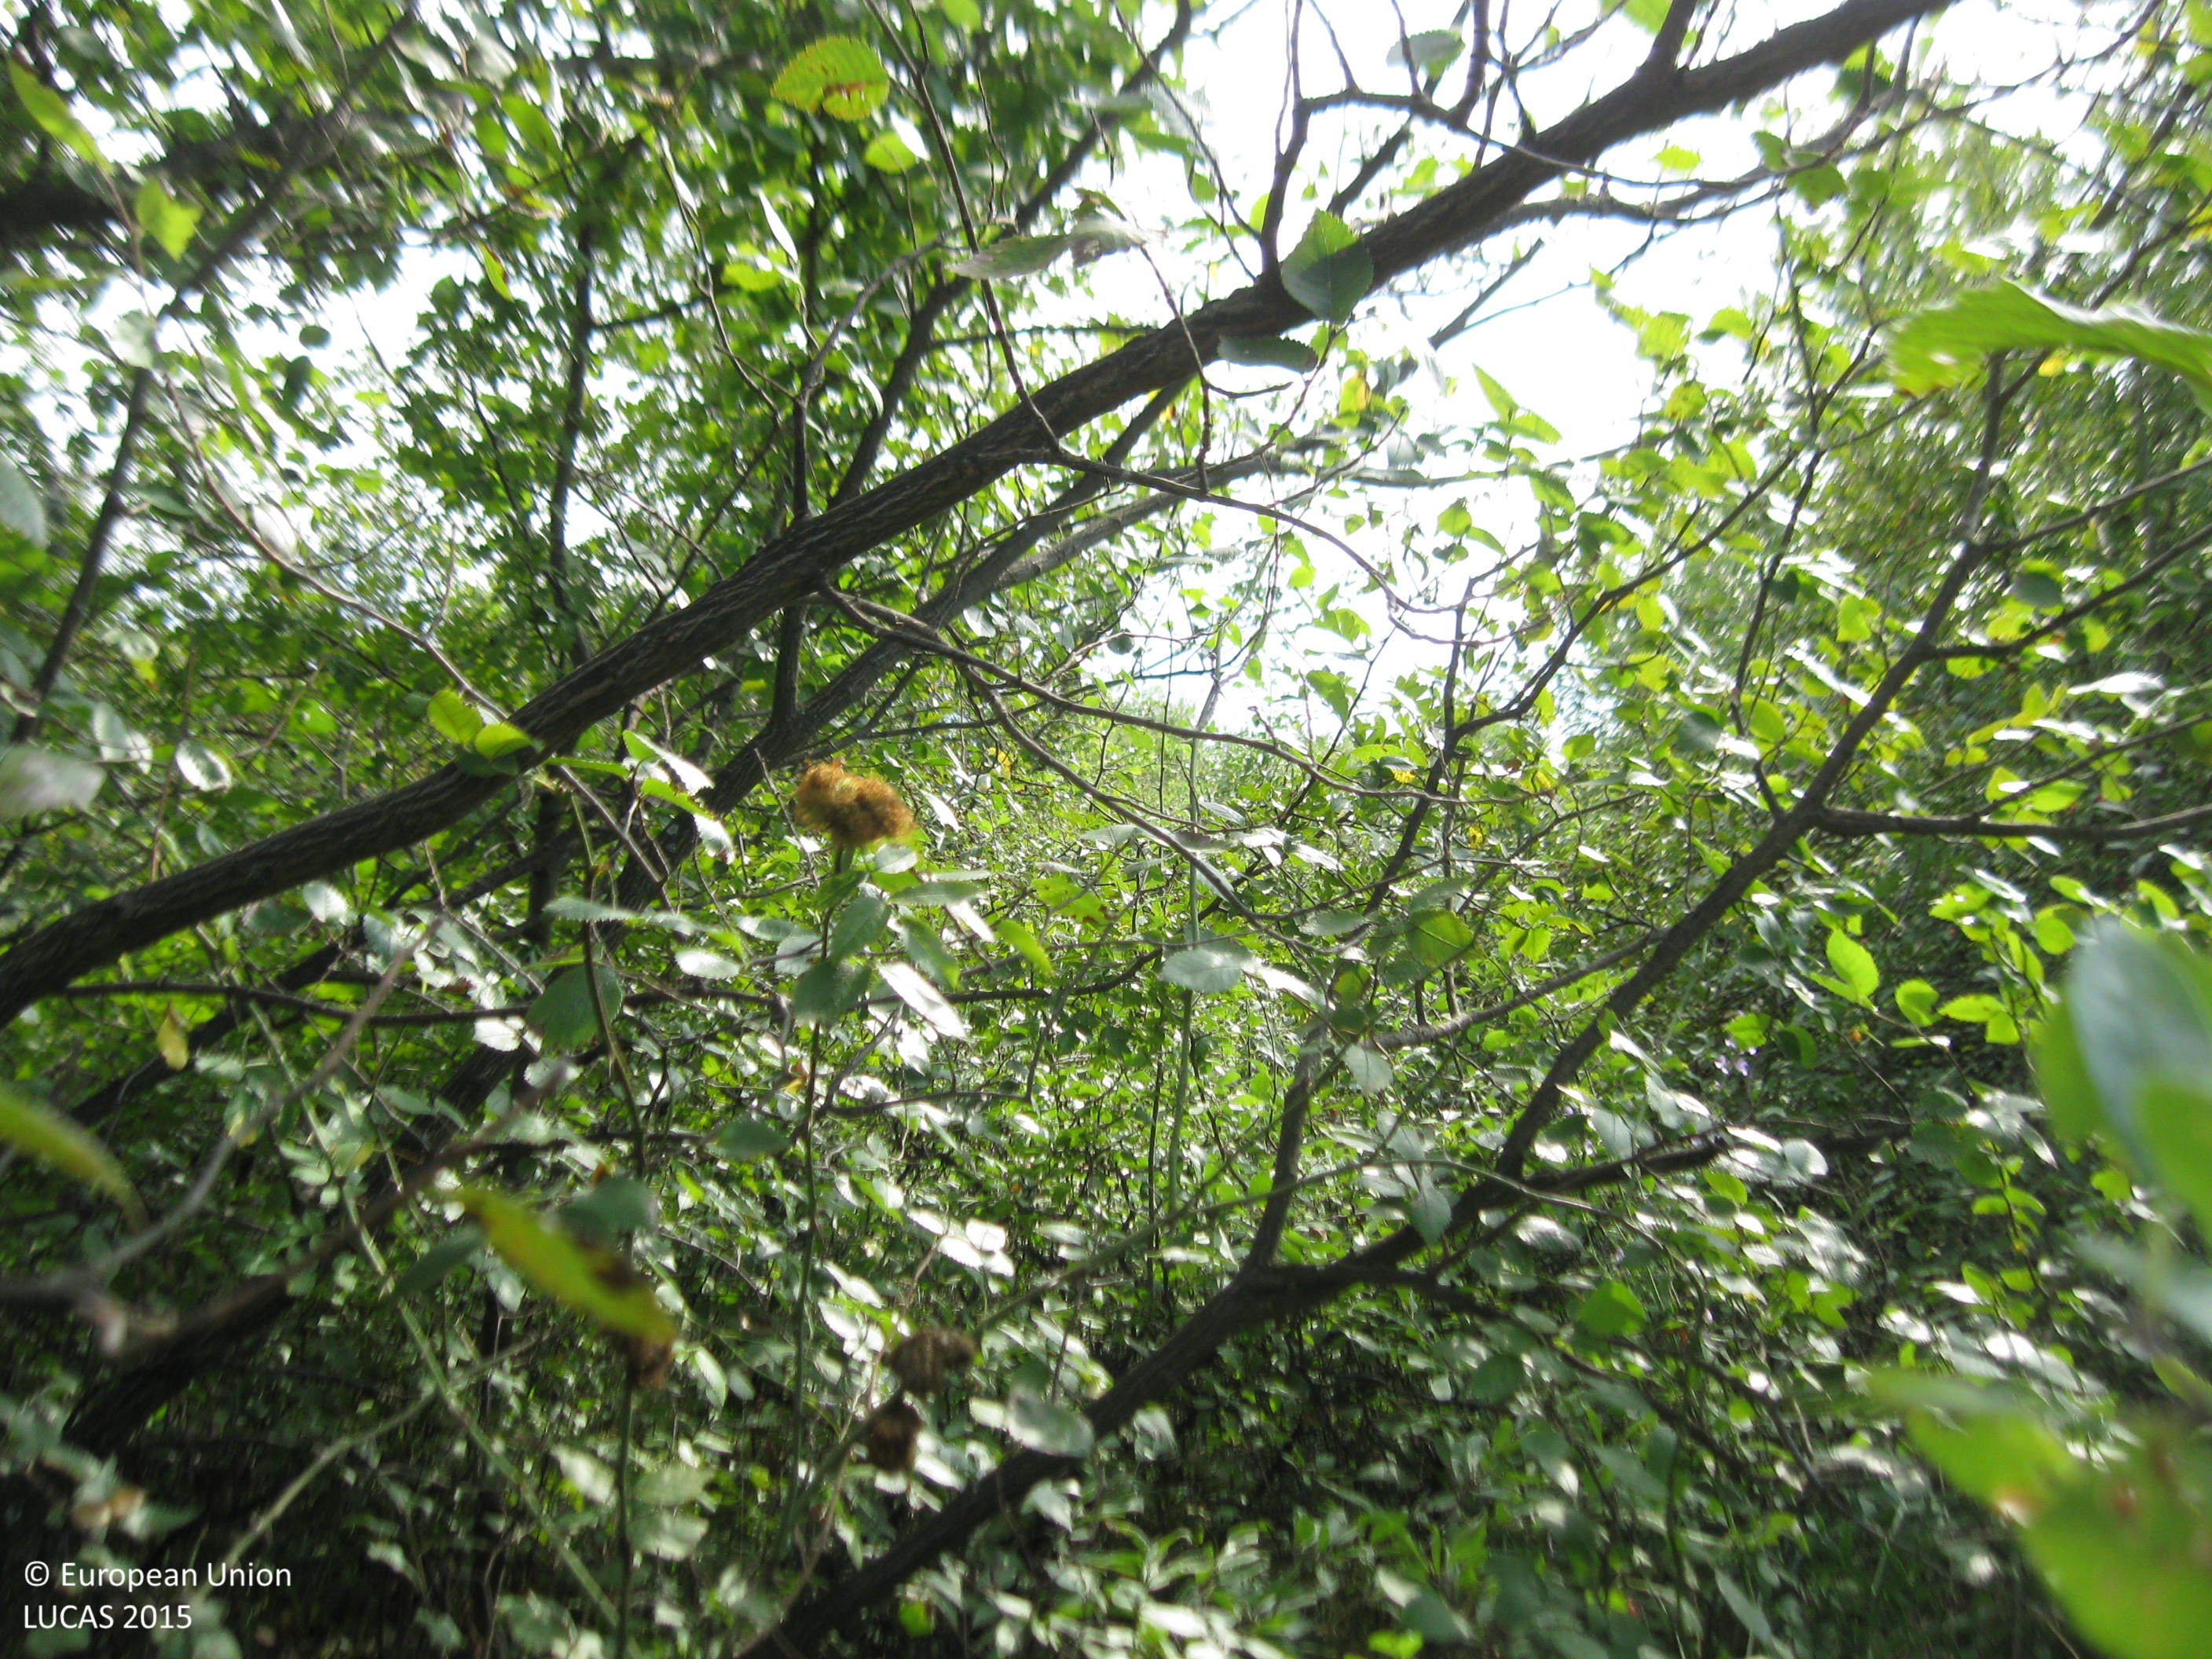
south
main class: Shrubland
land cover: Shrubland with sparse tree cover
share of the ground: > 75 %
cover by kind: shrubs 90 %, broadleaved forest trees 5 %, herbaceous plants 5 %
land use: Abandoned areas
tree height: < 5 m
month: September
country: BG
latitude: 42.1175
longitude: 24.9930
